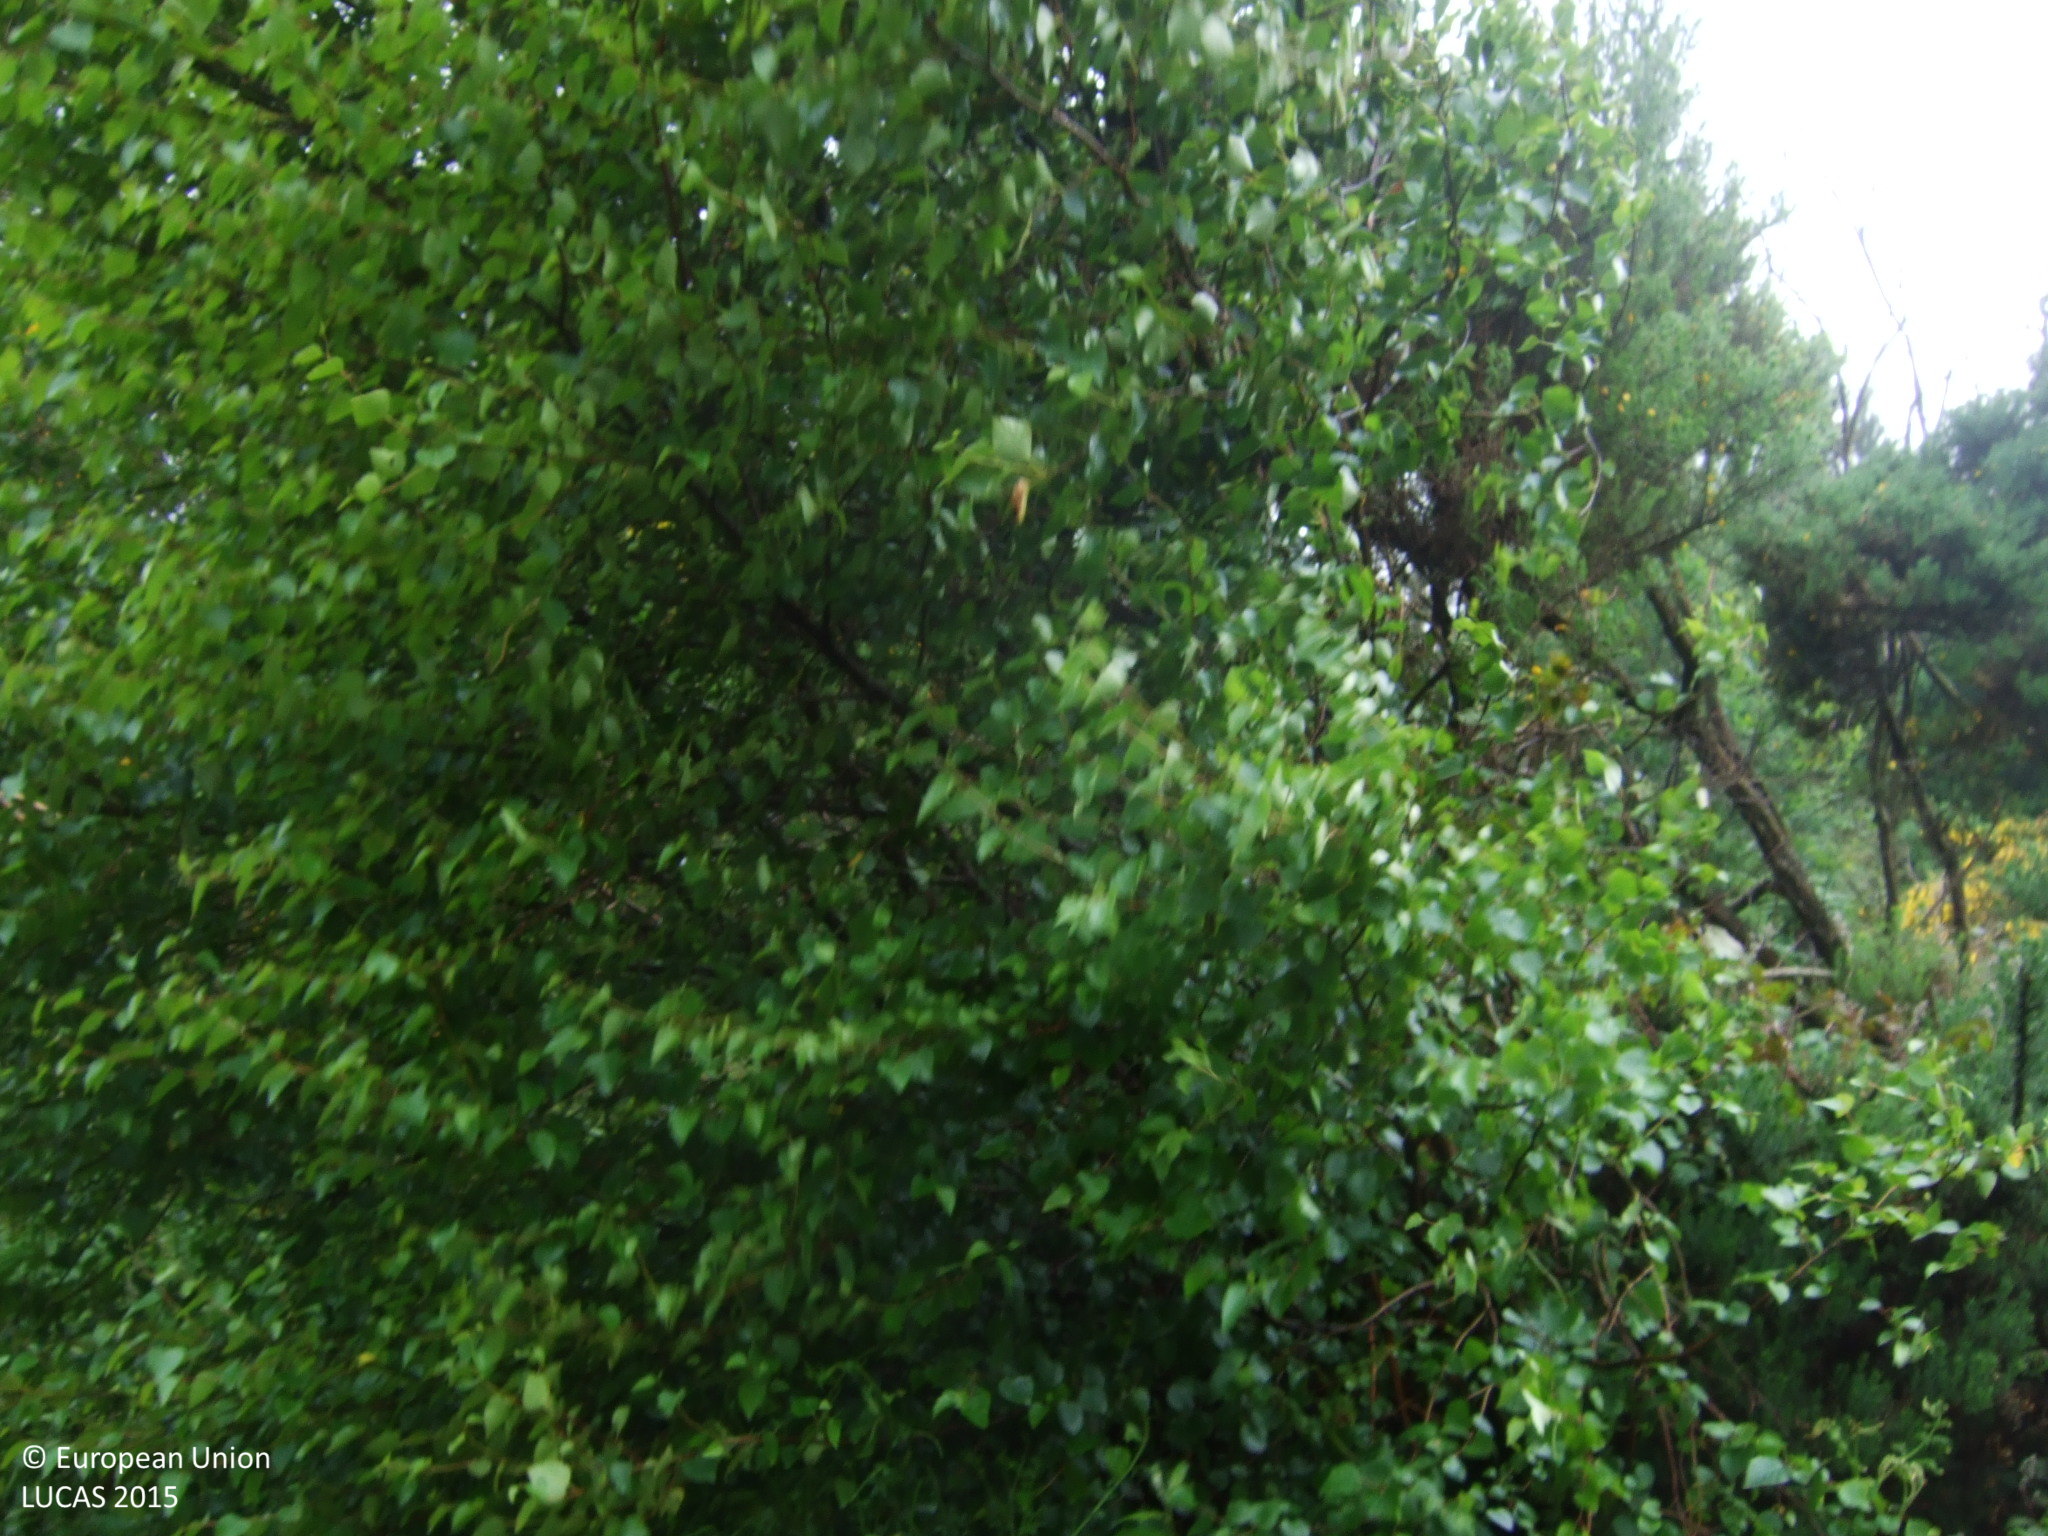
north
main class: Woodland
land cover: Pine dominated mixed woodland
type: exotic forest
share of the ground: 50 - 75 %
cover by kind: coniferous forest trees 40 %, shrubs 35 %, broadleaved forest trees 25 %
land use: Forestry
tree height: > 5 m
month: June
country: ES
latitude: 43.3448
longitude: -7.5107
